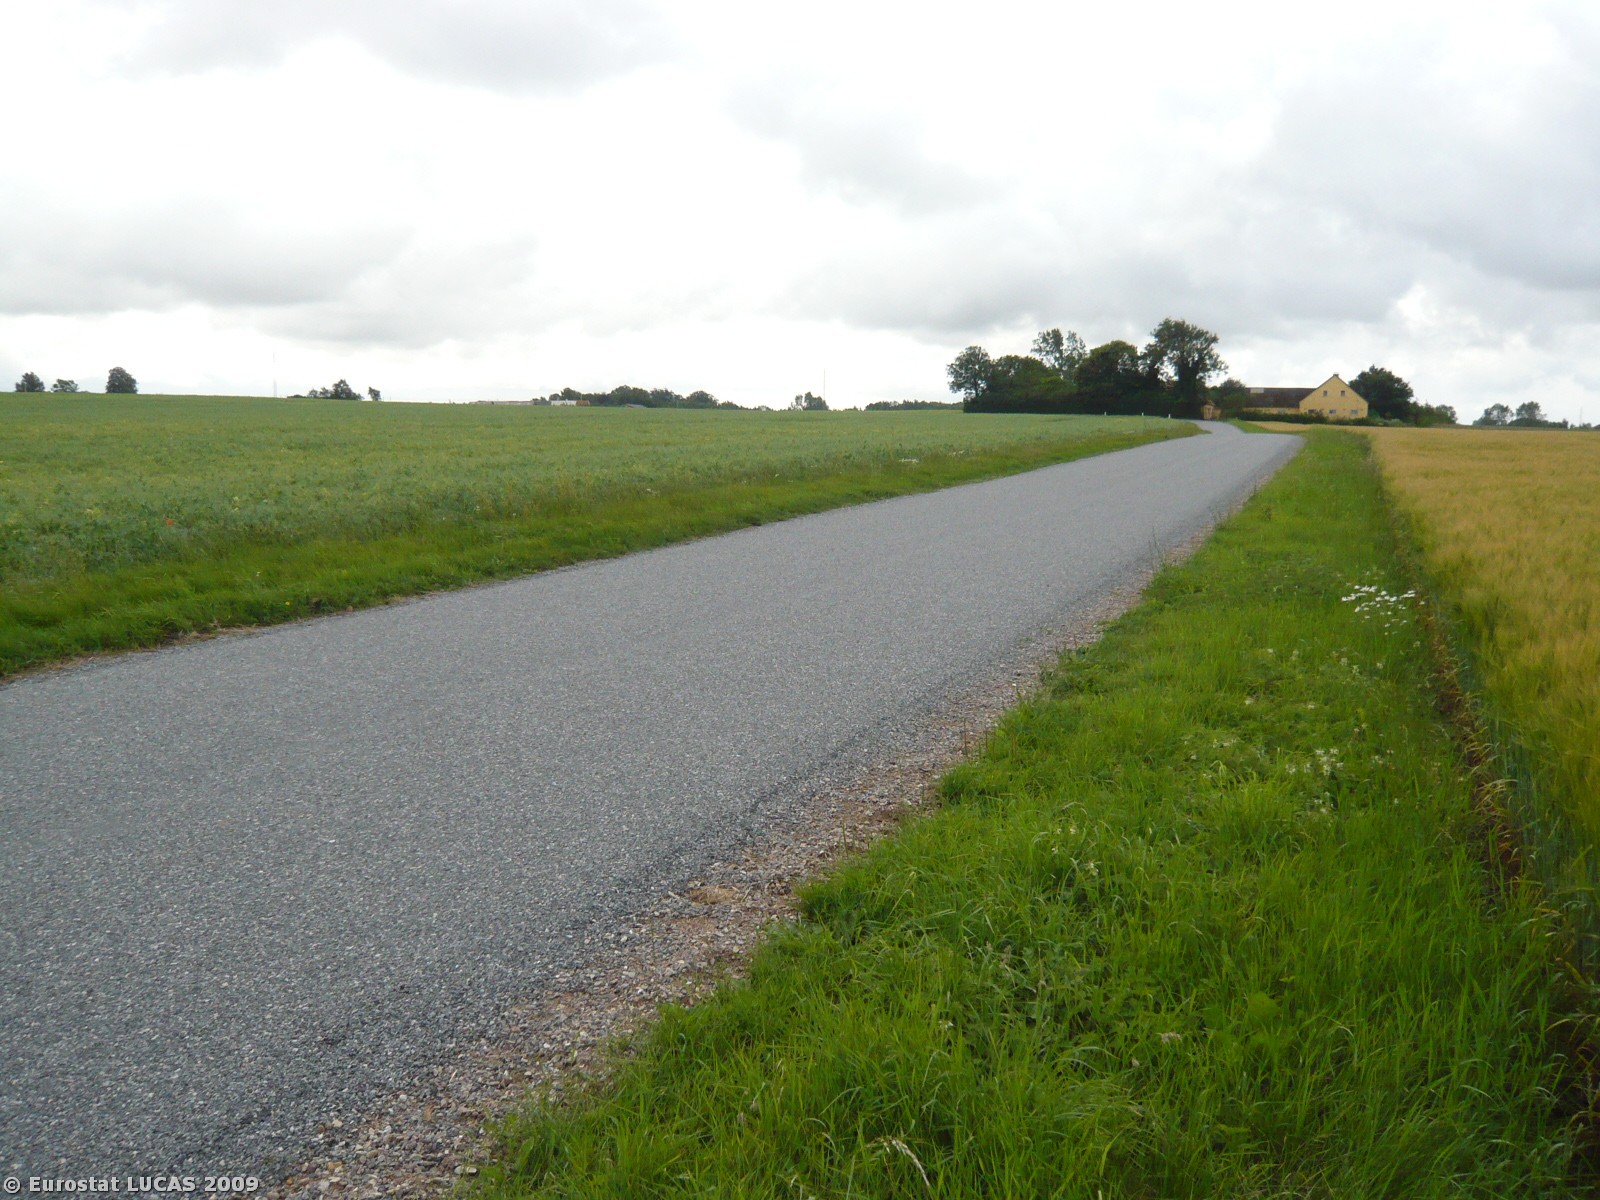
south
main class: Cropland
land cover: Barley
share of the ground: > 75 %
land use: Agriculture (excluding fallow land and kitchen gardens)
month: July
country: DK
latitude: 55.3904
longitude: 11.2776
